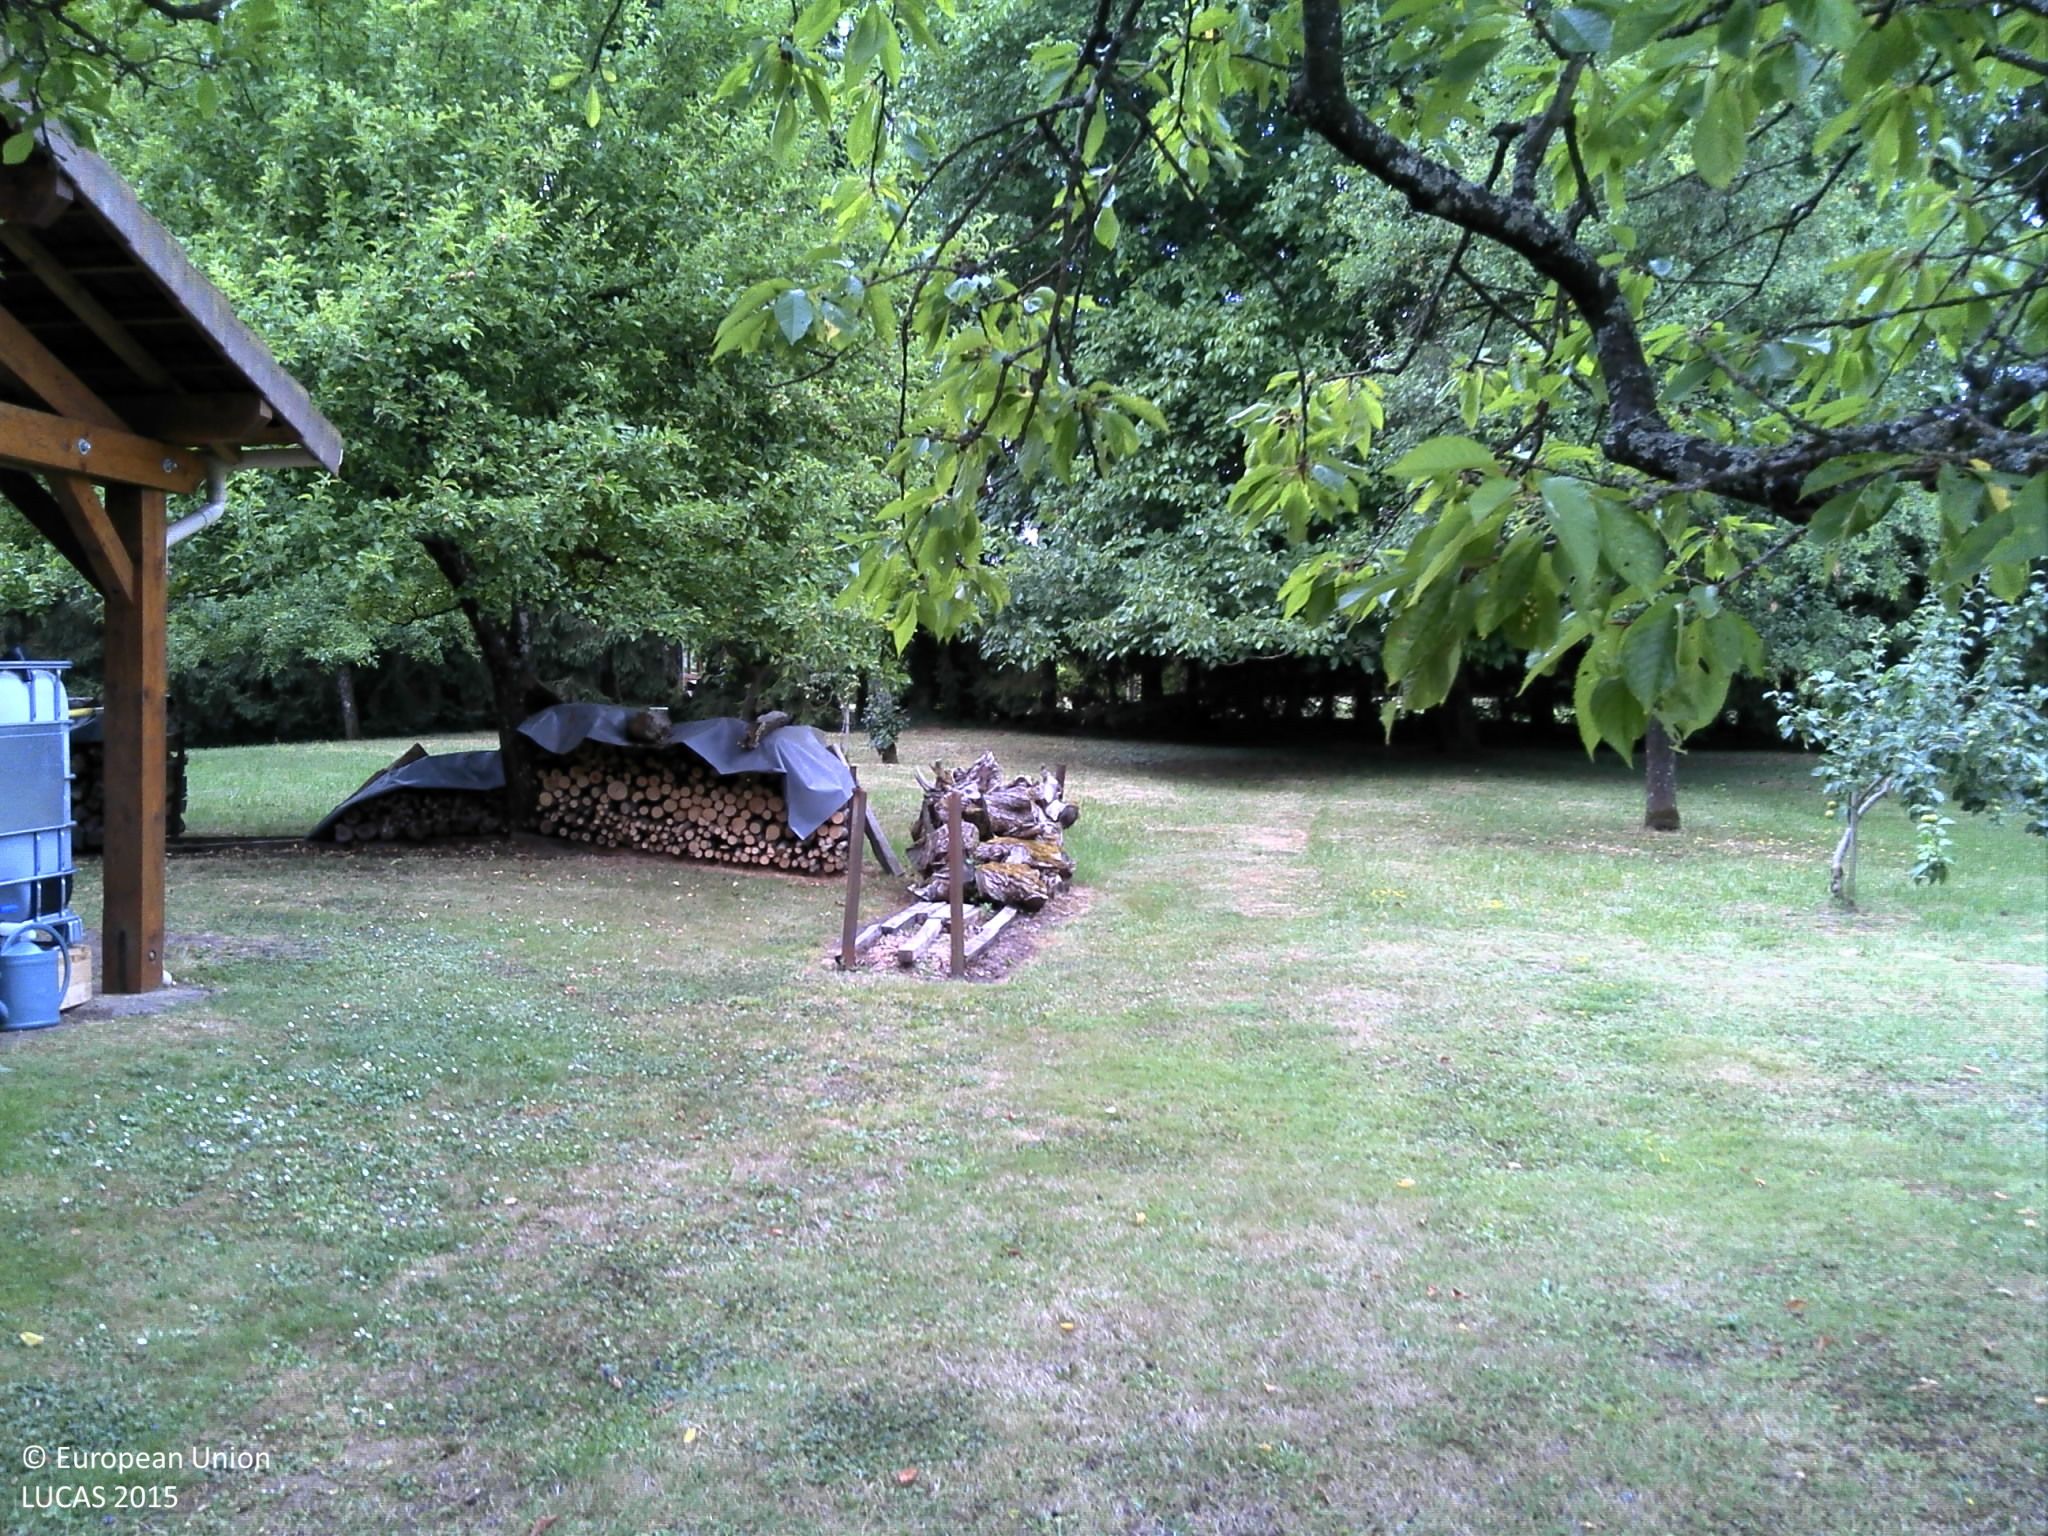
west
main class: Grassland
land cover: Grassland with sparse tree/shrub cover
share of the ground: > 75 %
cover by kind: herbaceous plants 95 %, broadleaved forest trees 5 %
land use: Residential
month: July
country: FR
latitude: 49.3006
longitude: 6.4381
